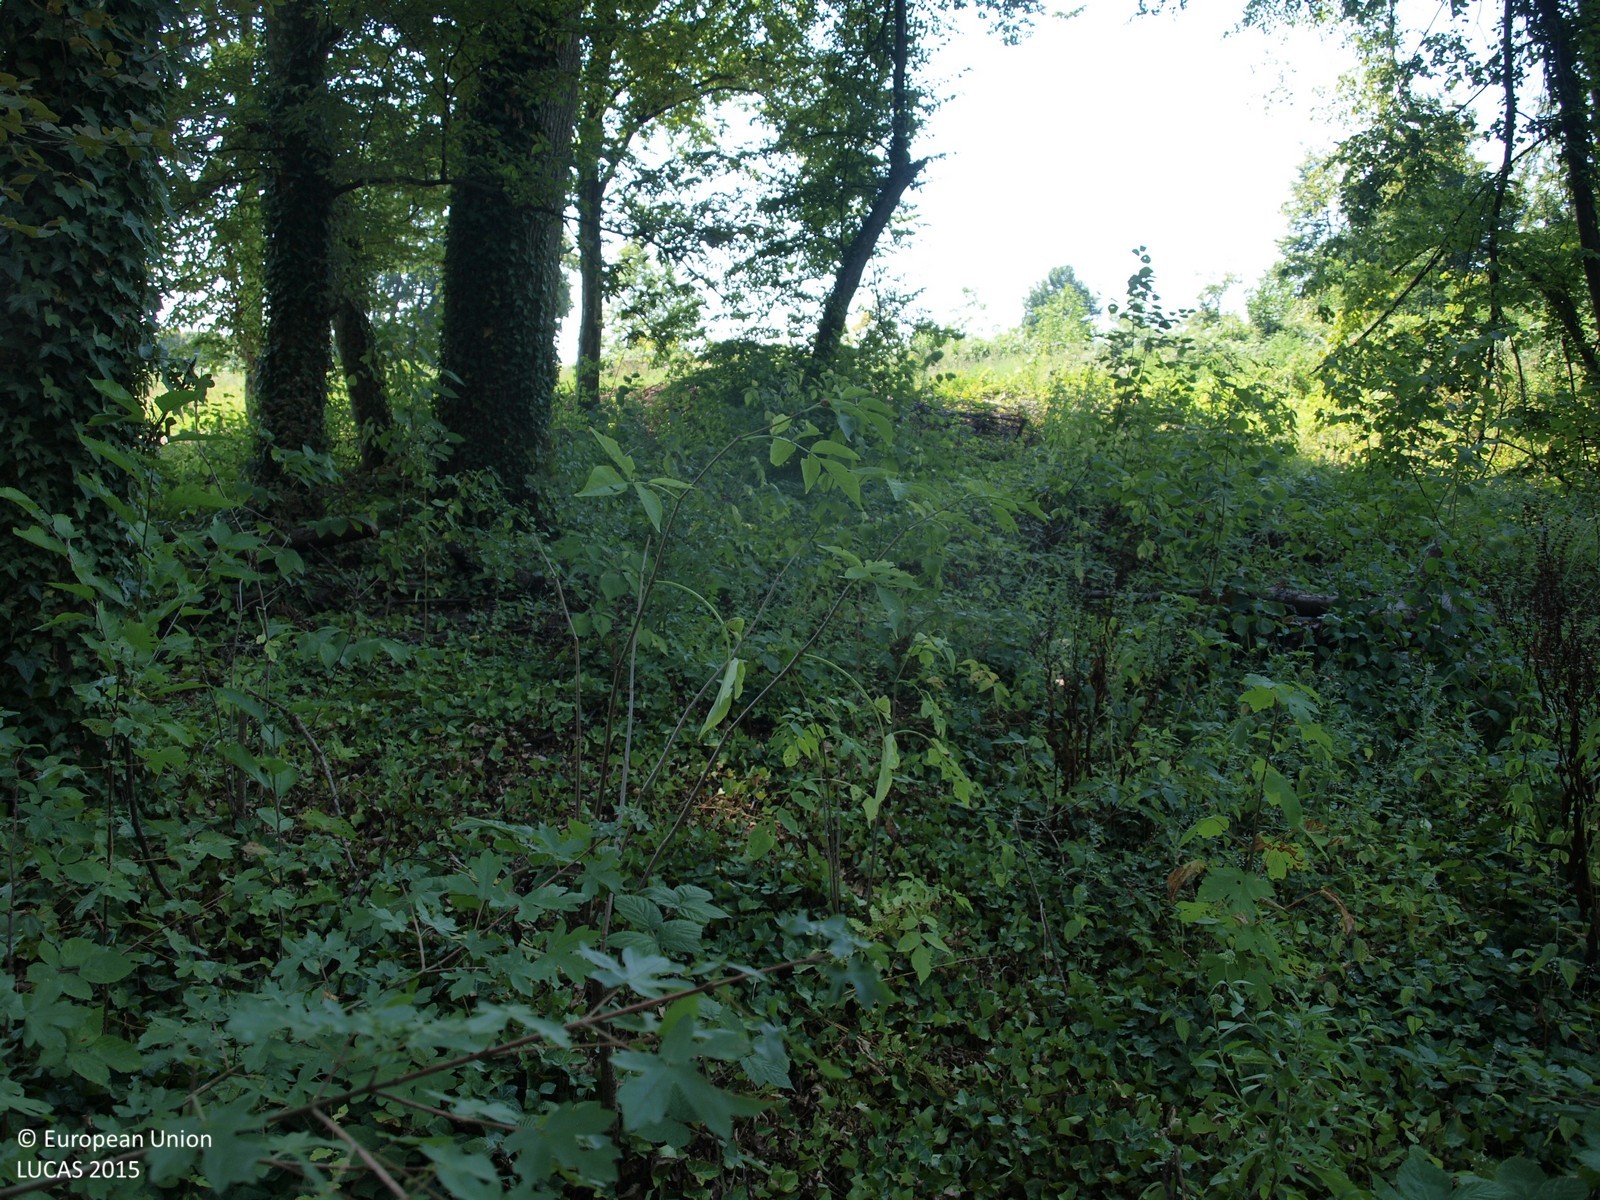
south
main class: Woodland
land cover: Broadleaved woodland
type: mesophytic deciduous forest
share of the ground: > 75 %
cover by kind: broadleaved forest trees 100 %
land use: Forestry
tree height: > 5 m
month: August
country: HR
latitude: 46.0255
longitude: 16.5236
